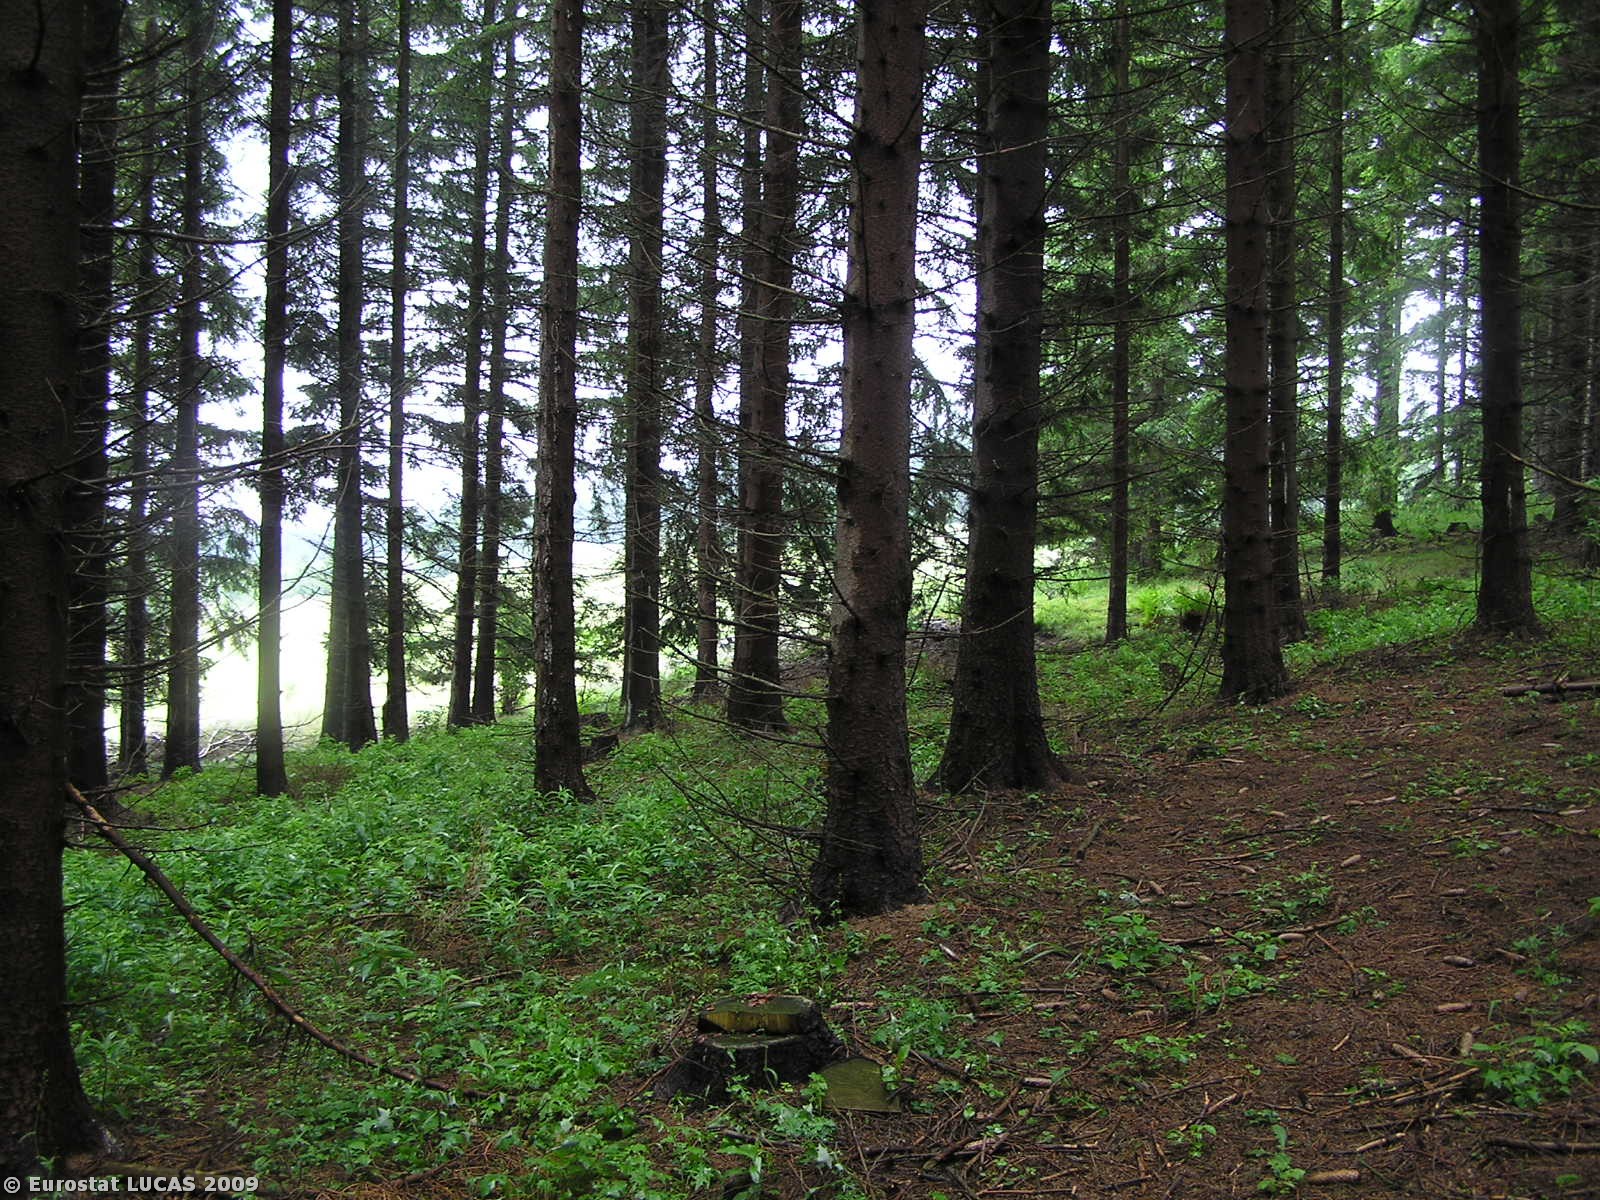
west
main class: Woodland
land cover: Coniferous woodland
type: hemiboreal forest and nemoral coniferous forest and mixed broadleaved-coniferous forest
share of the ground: > 75 %
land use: Forestry
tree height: > 5 m
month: May
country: CZ
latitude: 50.1395
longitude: 17.4418
